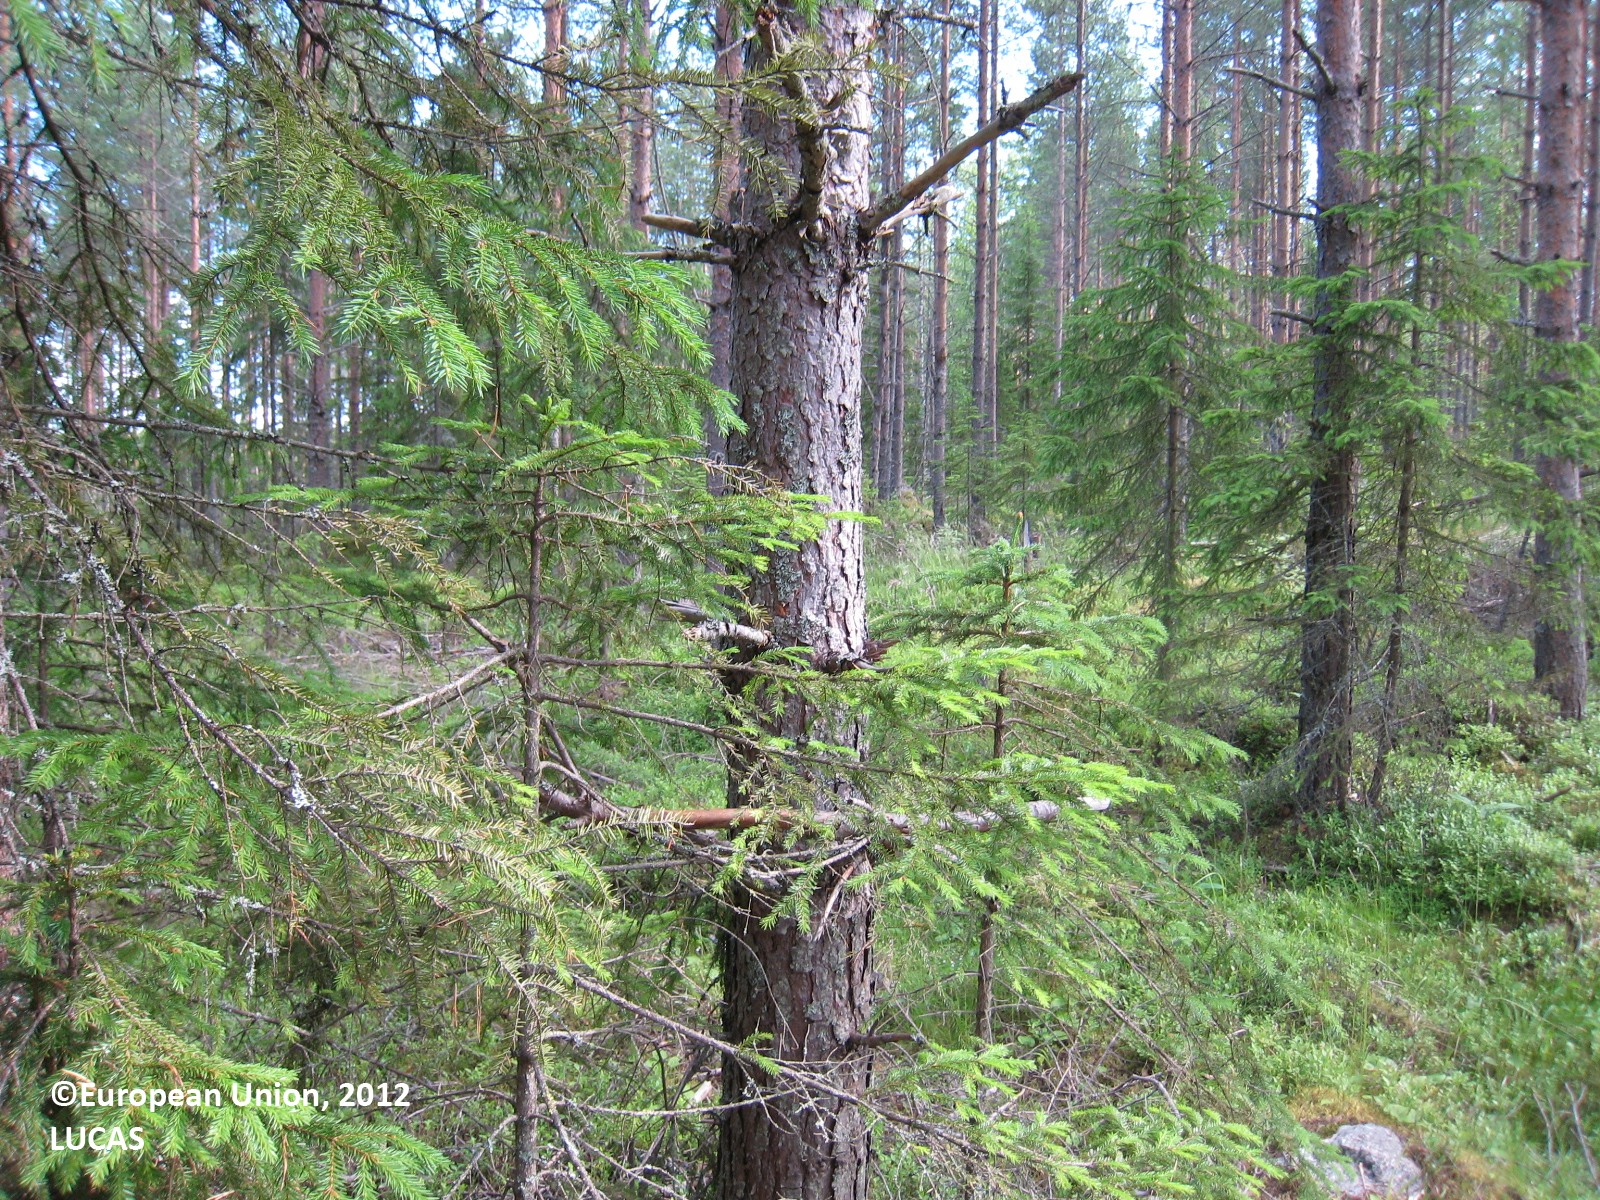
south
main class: Woodland
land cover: Other coniferous woodland
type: boreal forest
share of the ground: 50 - 75 %
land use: Forestry
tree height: > 5 m
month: July
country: FI
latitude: 62.7786
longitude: 25.6920
